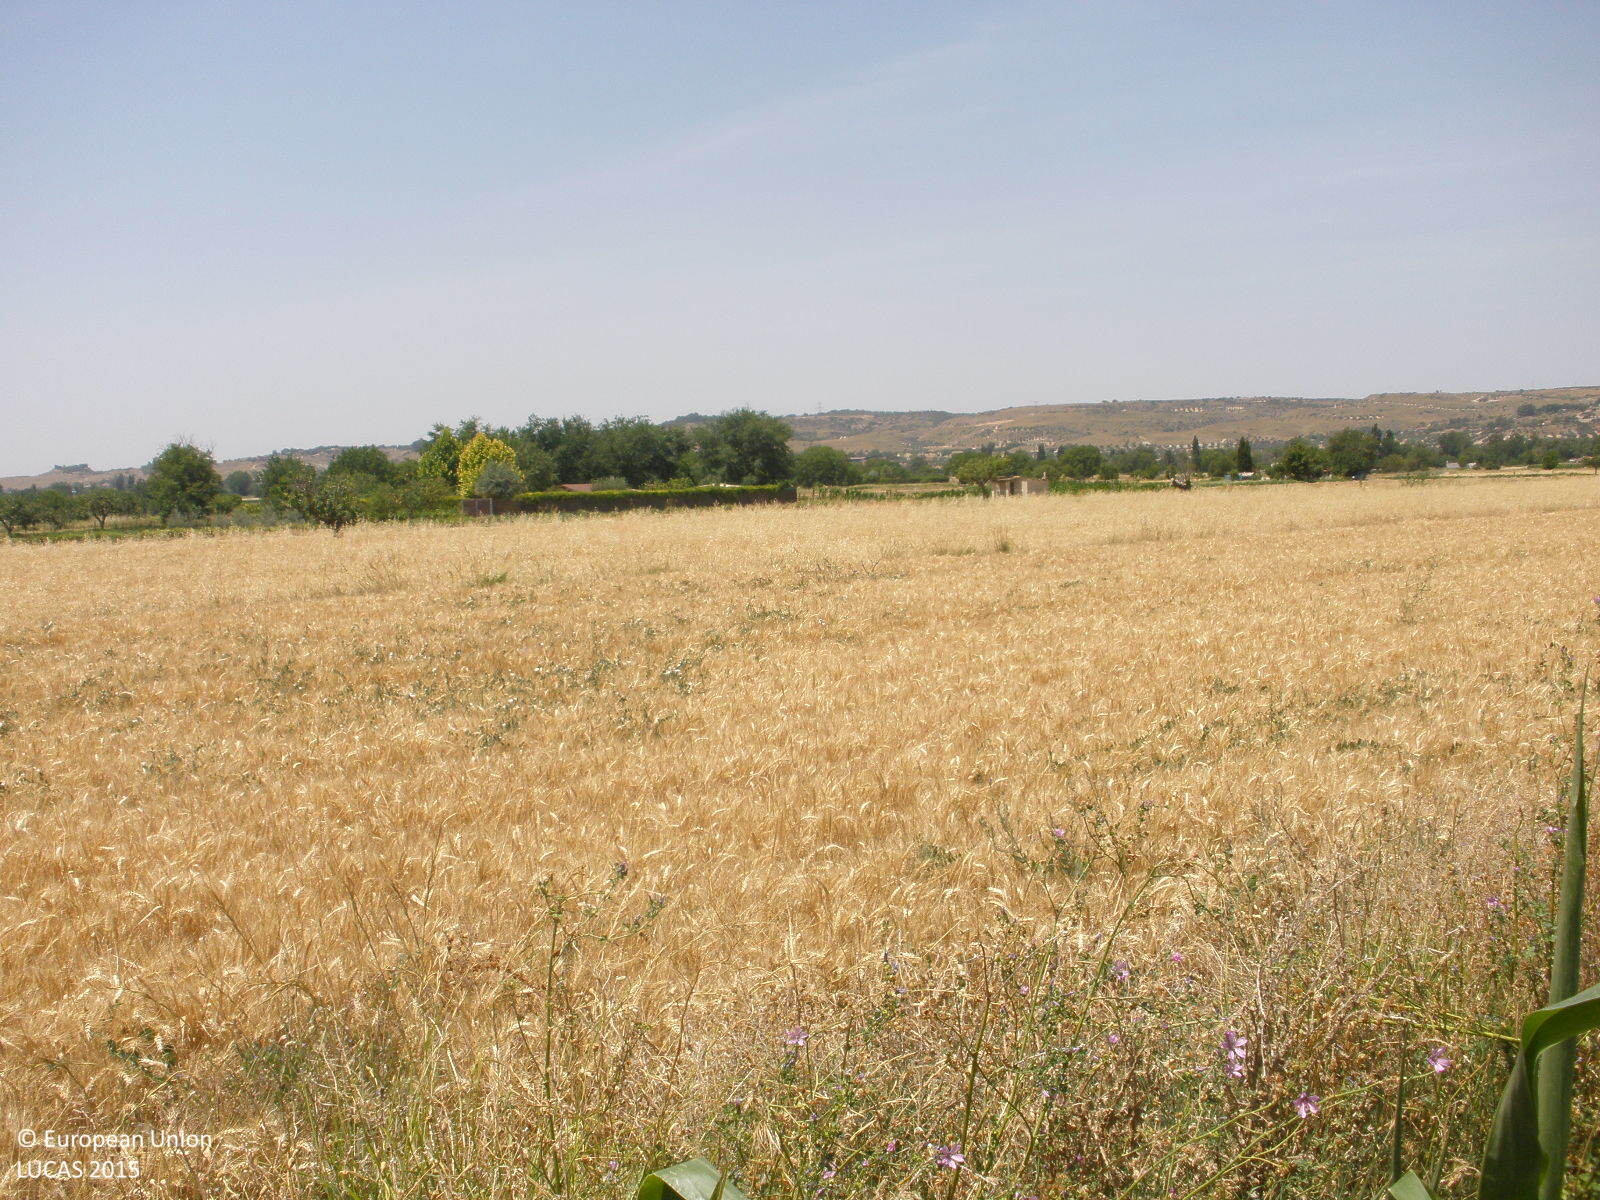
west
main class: Cropland
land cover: Maize
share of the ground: > 75 %
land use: Agriculture (excluding fallow land and kitchen gardens)
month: July
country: ES
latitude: 40.2171
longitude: -3.4389
